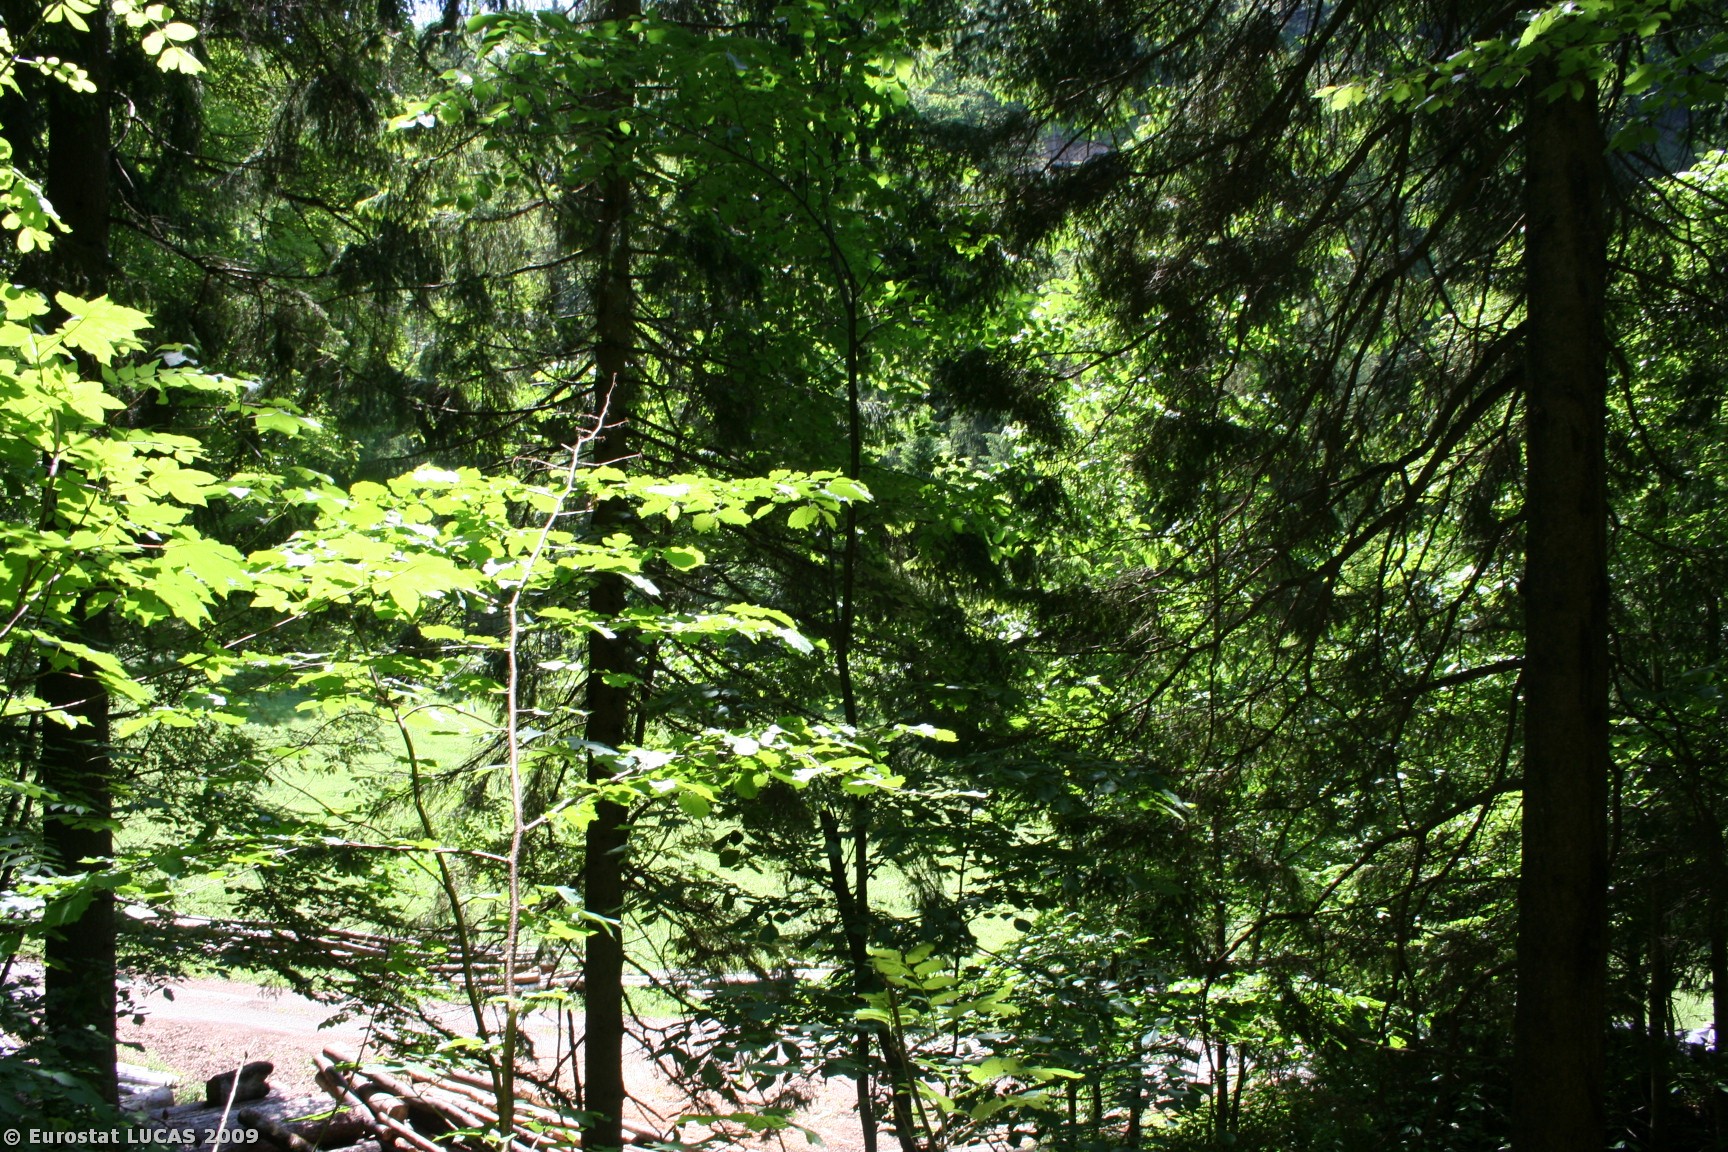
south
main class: Woodland
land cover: Mixed woodland
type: hemiboreal forest and nemoral coniferous forest and mixed broadleaved-coniferous forest
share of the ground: > 75 %
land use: Forestry
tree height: > 5 m
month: May
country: AT
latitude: 47.6007
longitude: 13.2039
